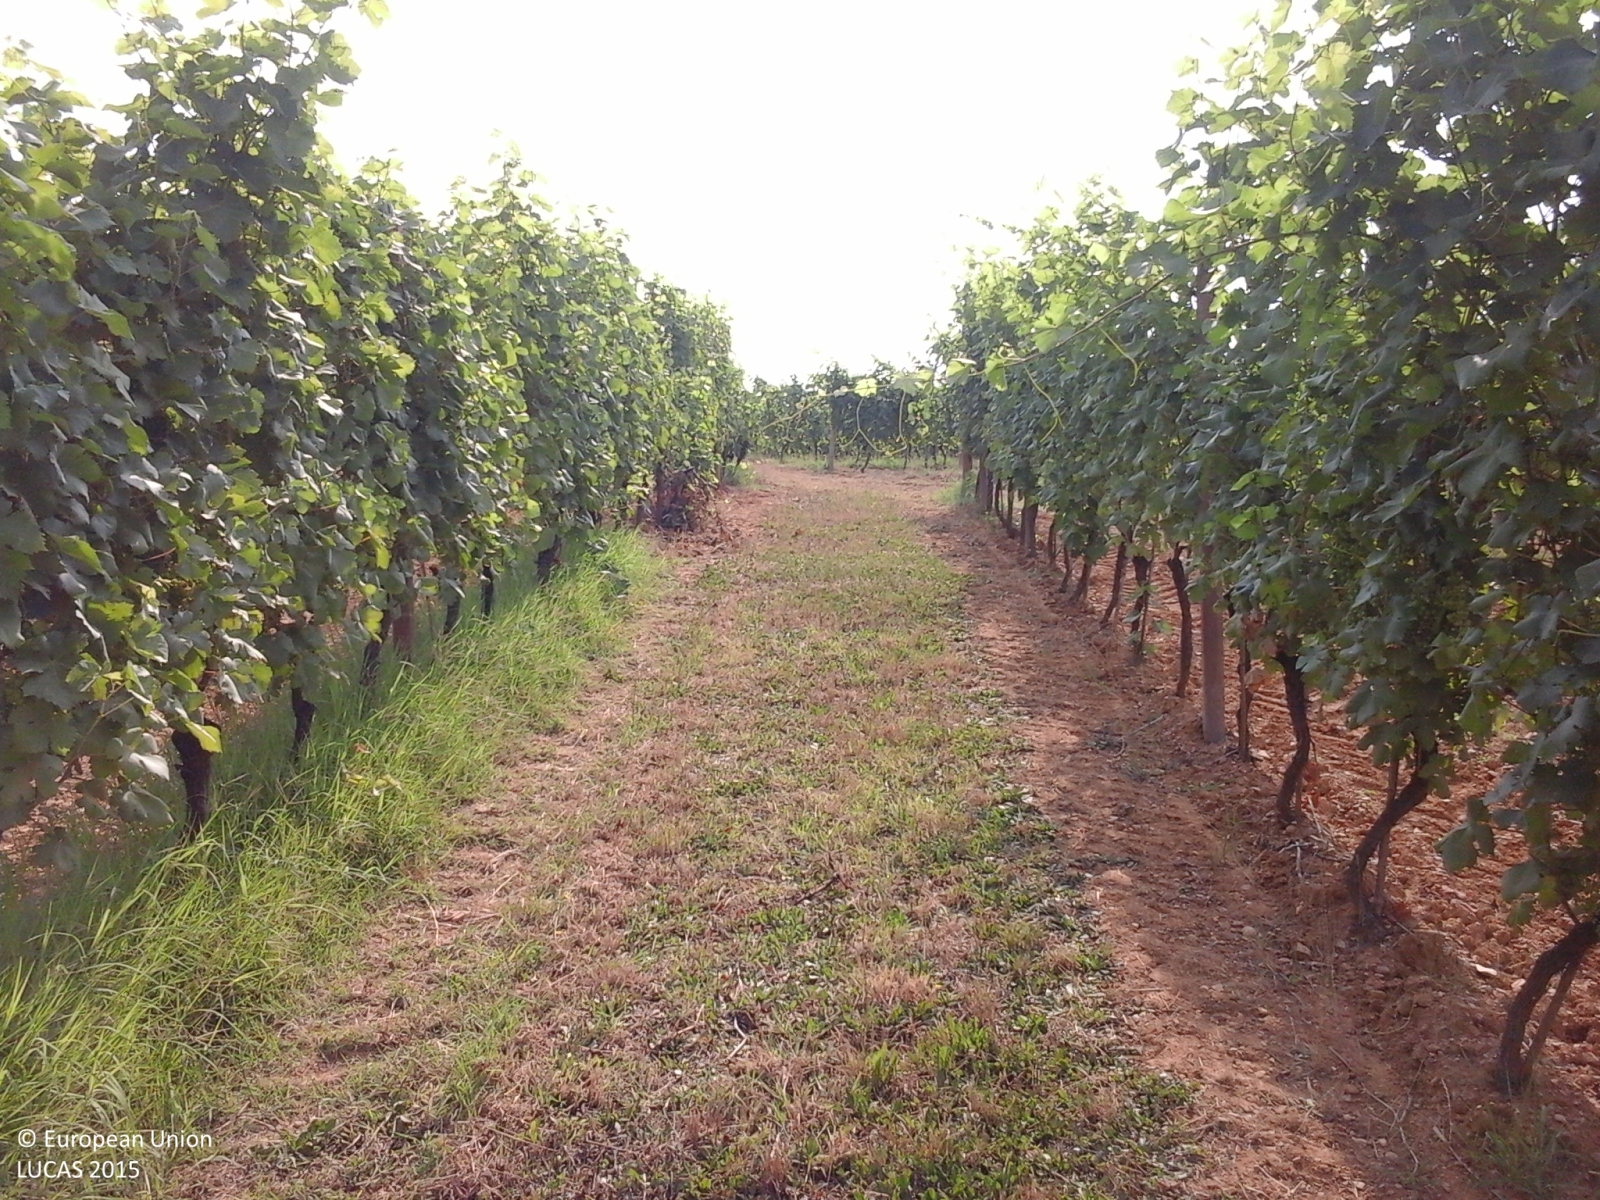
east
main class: Cropland
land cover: Vineyards
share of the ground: 25 - 50 %
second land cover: Grassland without tree/shrub cover
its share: > 75 %
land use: Agriculture (excluding fallow land and kitchen gardens)
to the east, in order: Vineyards; Grassland without tree/shrub cover; Tracks; Vineyards; Electric lines; Vineyards; Tracks; Vineyards
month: July
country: IT
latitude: 44.7404
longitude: 8.8027
